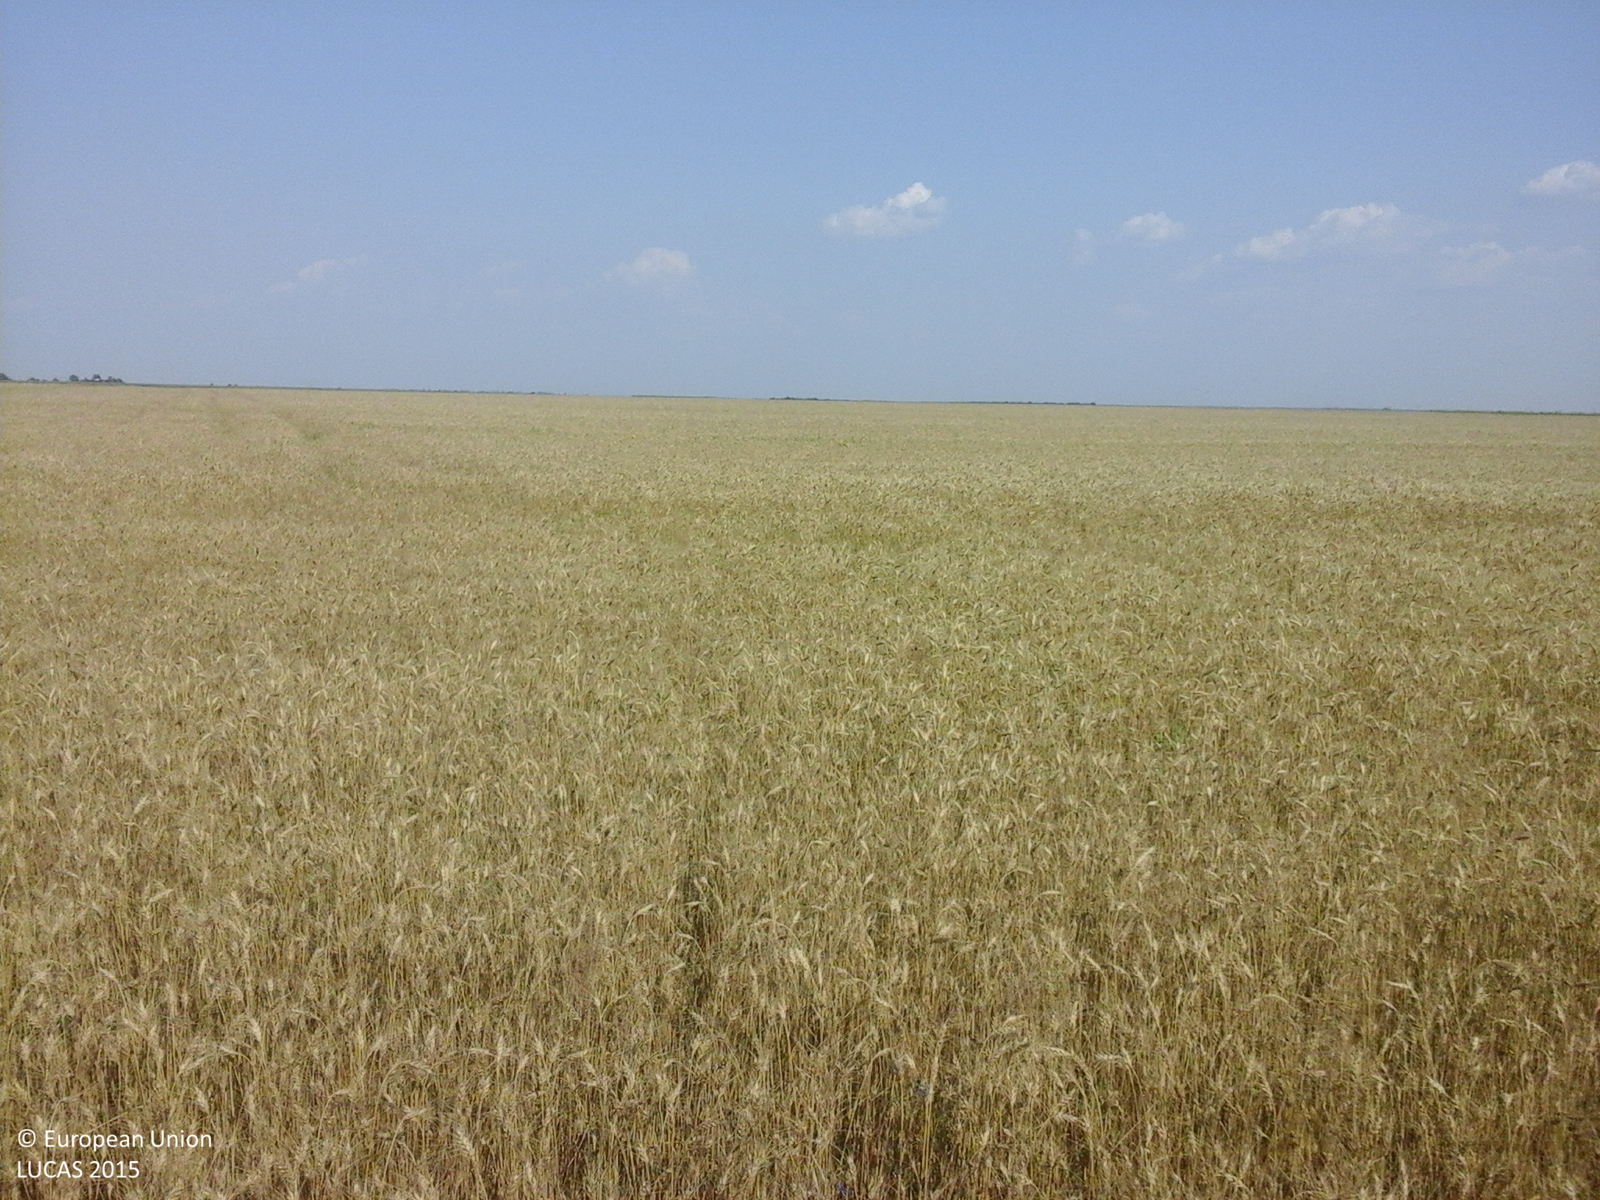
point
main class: Cropland
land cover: Common wheat
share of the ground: > 75 %
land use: Agriculture (excluding fallow land and kitchen gardens)
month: July
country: RO
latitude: 44.6490
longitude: 24.9732
